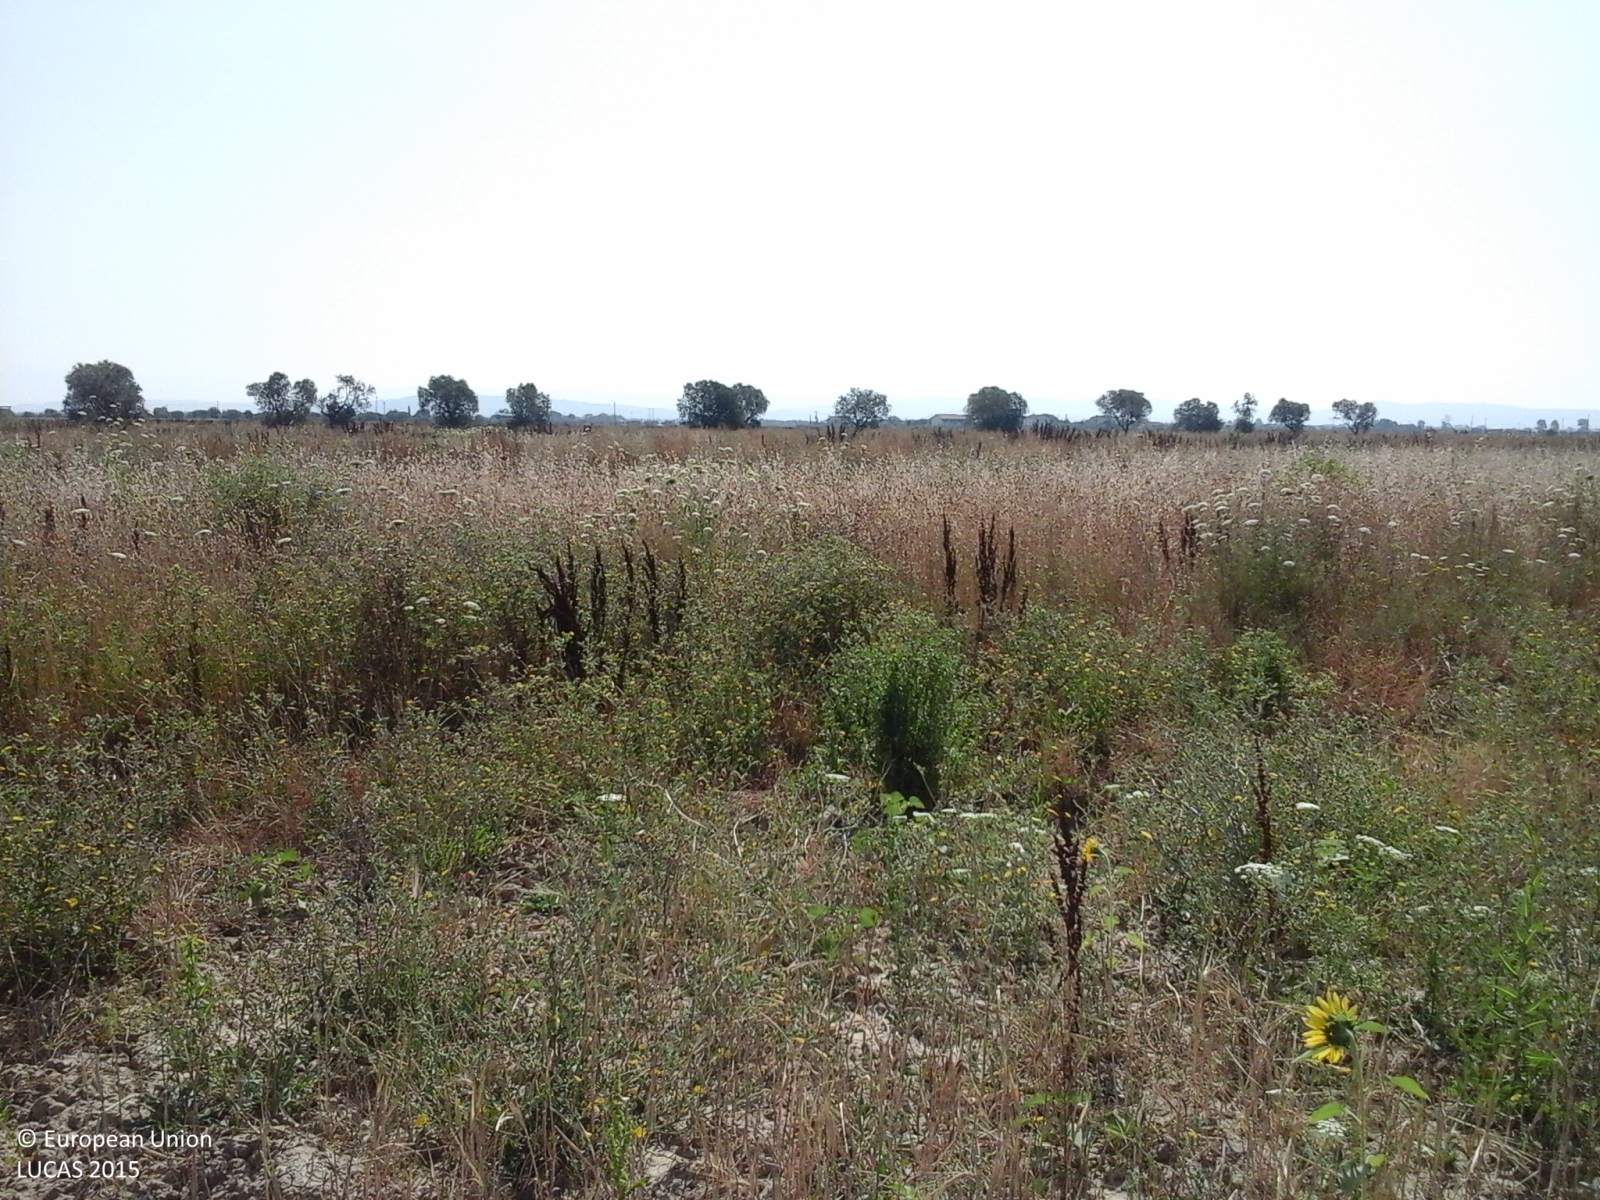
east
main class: Cropland
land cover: Barley
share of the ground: > 75 %
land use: Agriculture (excluding fallow land and kitchen gardens)
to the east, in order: Barley; Ditches and canals; Spontaneously vegetated surfaces; Ditches and canals; Spontaneously vegetated surfaces; Ditches and canals; Spontaneously vegetated surfaces; Ditches and canals; Spontaneously vegetated surfaces; Ditches and canals; Spontaneously vegetated surfaces; Ditches and canals; Spontaneously vegetated surfaces; Ditches and canals; Spontaneously vegetated surfaces; Ditches and canals; Clovers
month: July
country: IT
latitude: 42.7210
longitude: 11.0346
